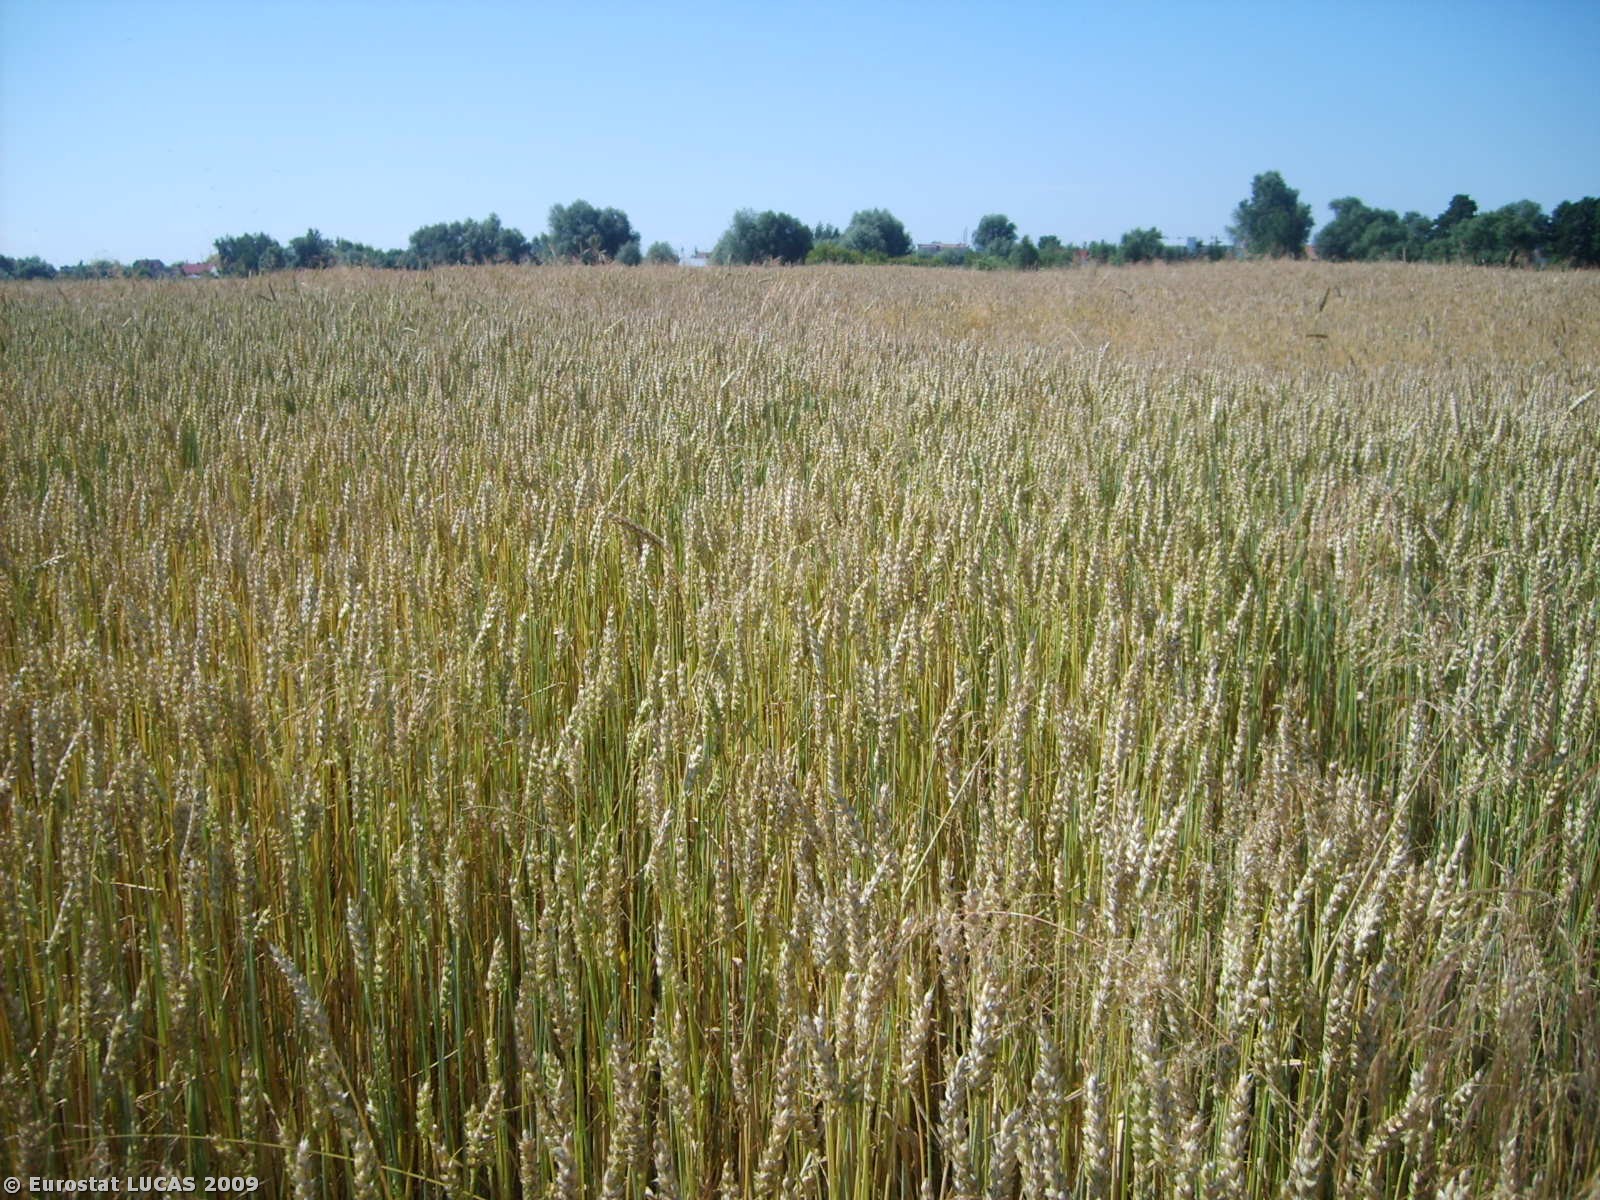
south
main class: Cropland
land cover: Common wheat
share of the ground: > 75 %
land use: Agriculture (excluding fallow land and kitchen gardens)
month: July
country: PL
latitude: 52.3954
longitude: 20.7545
